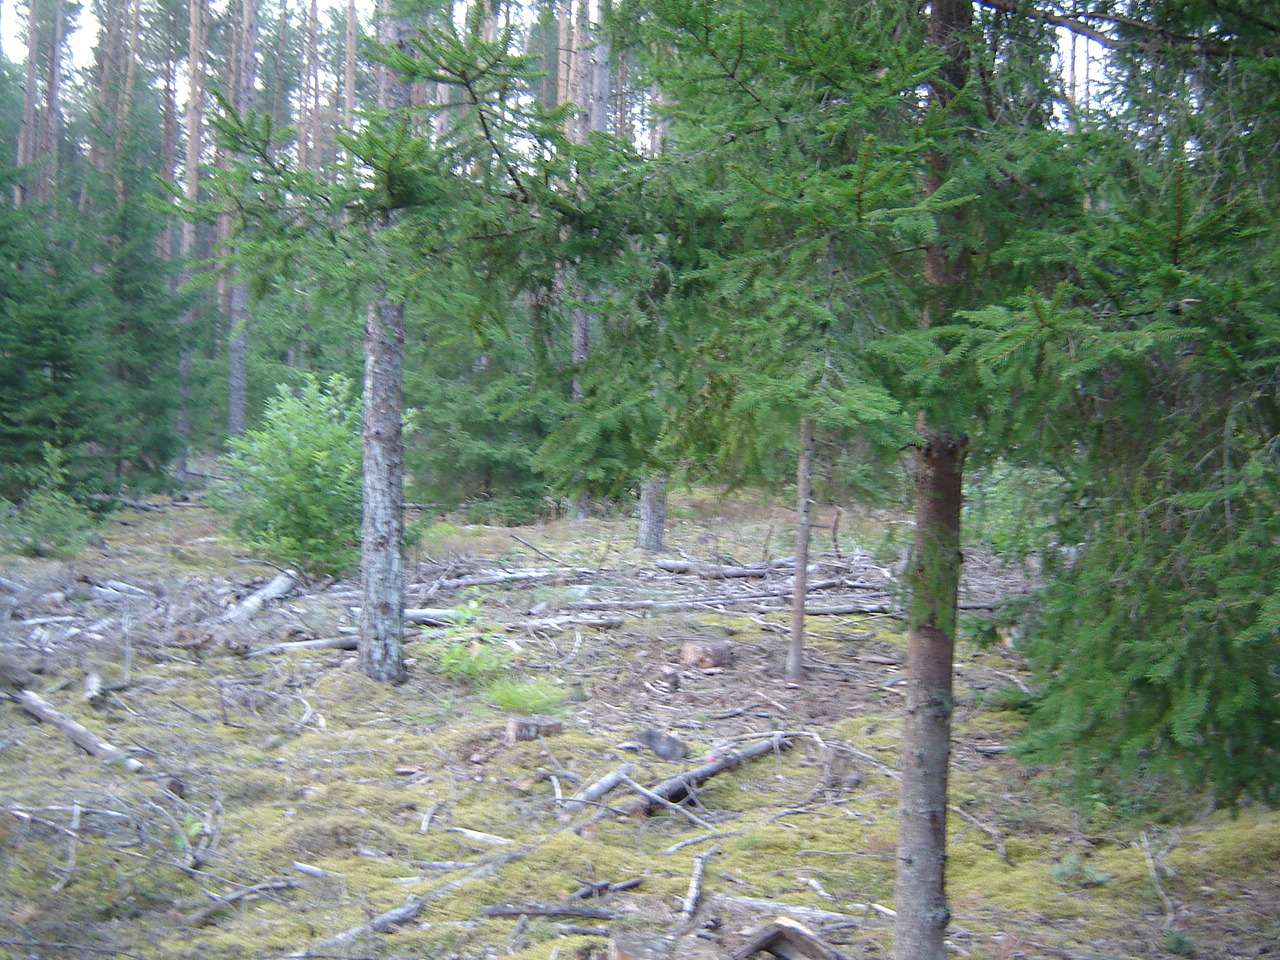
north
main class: Woodland
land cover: Pine dominated coniferous woodland
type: hemiboreal forest and nemoral coniferous forest and mixed broadleaved-coniferous forest
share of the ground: 50 - 75 %
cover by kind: coniferous forest trees 60 %, lichens and mosses 35 %, broadleaved forest trees 5 %
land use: Forestry
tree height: > 5 m
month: September
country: LT
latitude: 54.4080
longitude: 24.7927
